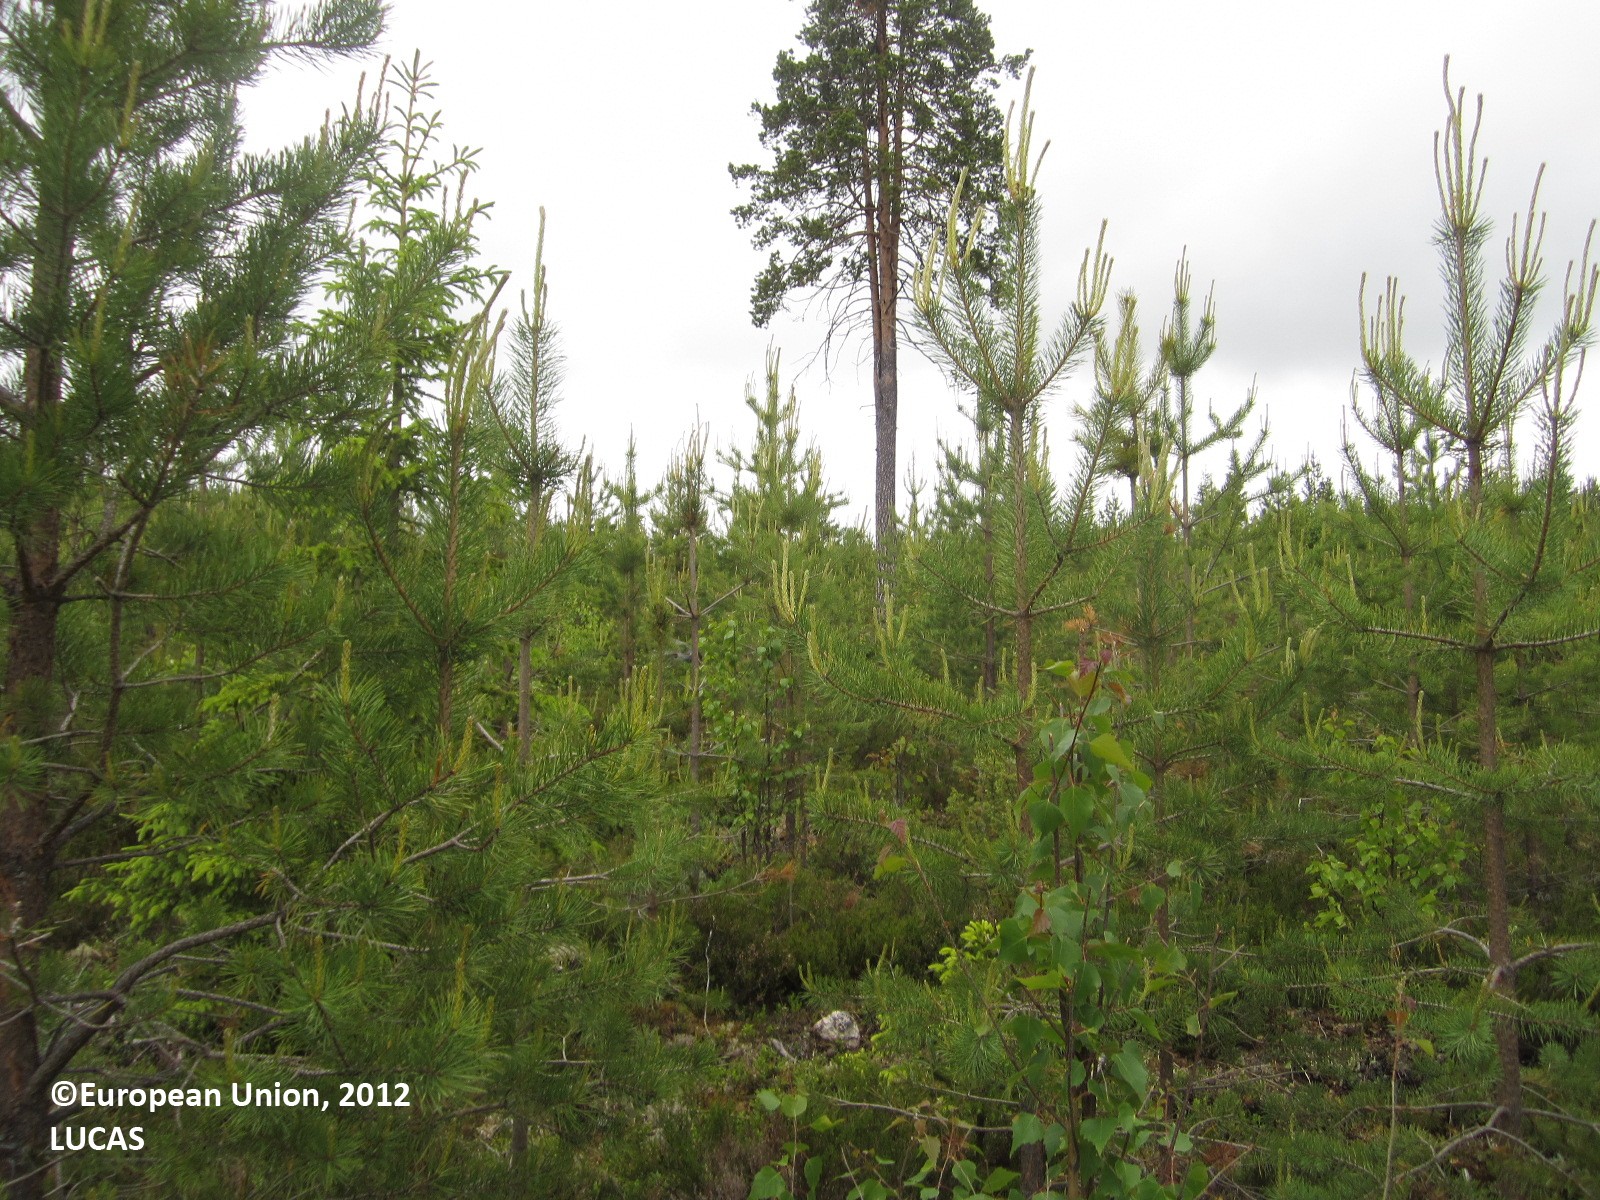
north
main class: Woodland
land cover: Pine dominated mixed woodland
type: boreal forest
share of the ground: 50 - 75 %
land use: Forestry
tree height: < 5 m
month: June
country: FI
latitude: 64.3570
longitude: 29.5830
